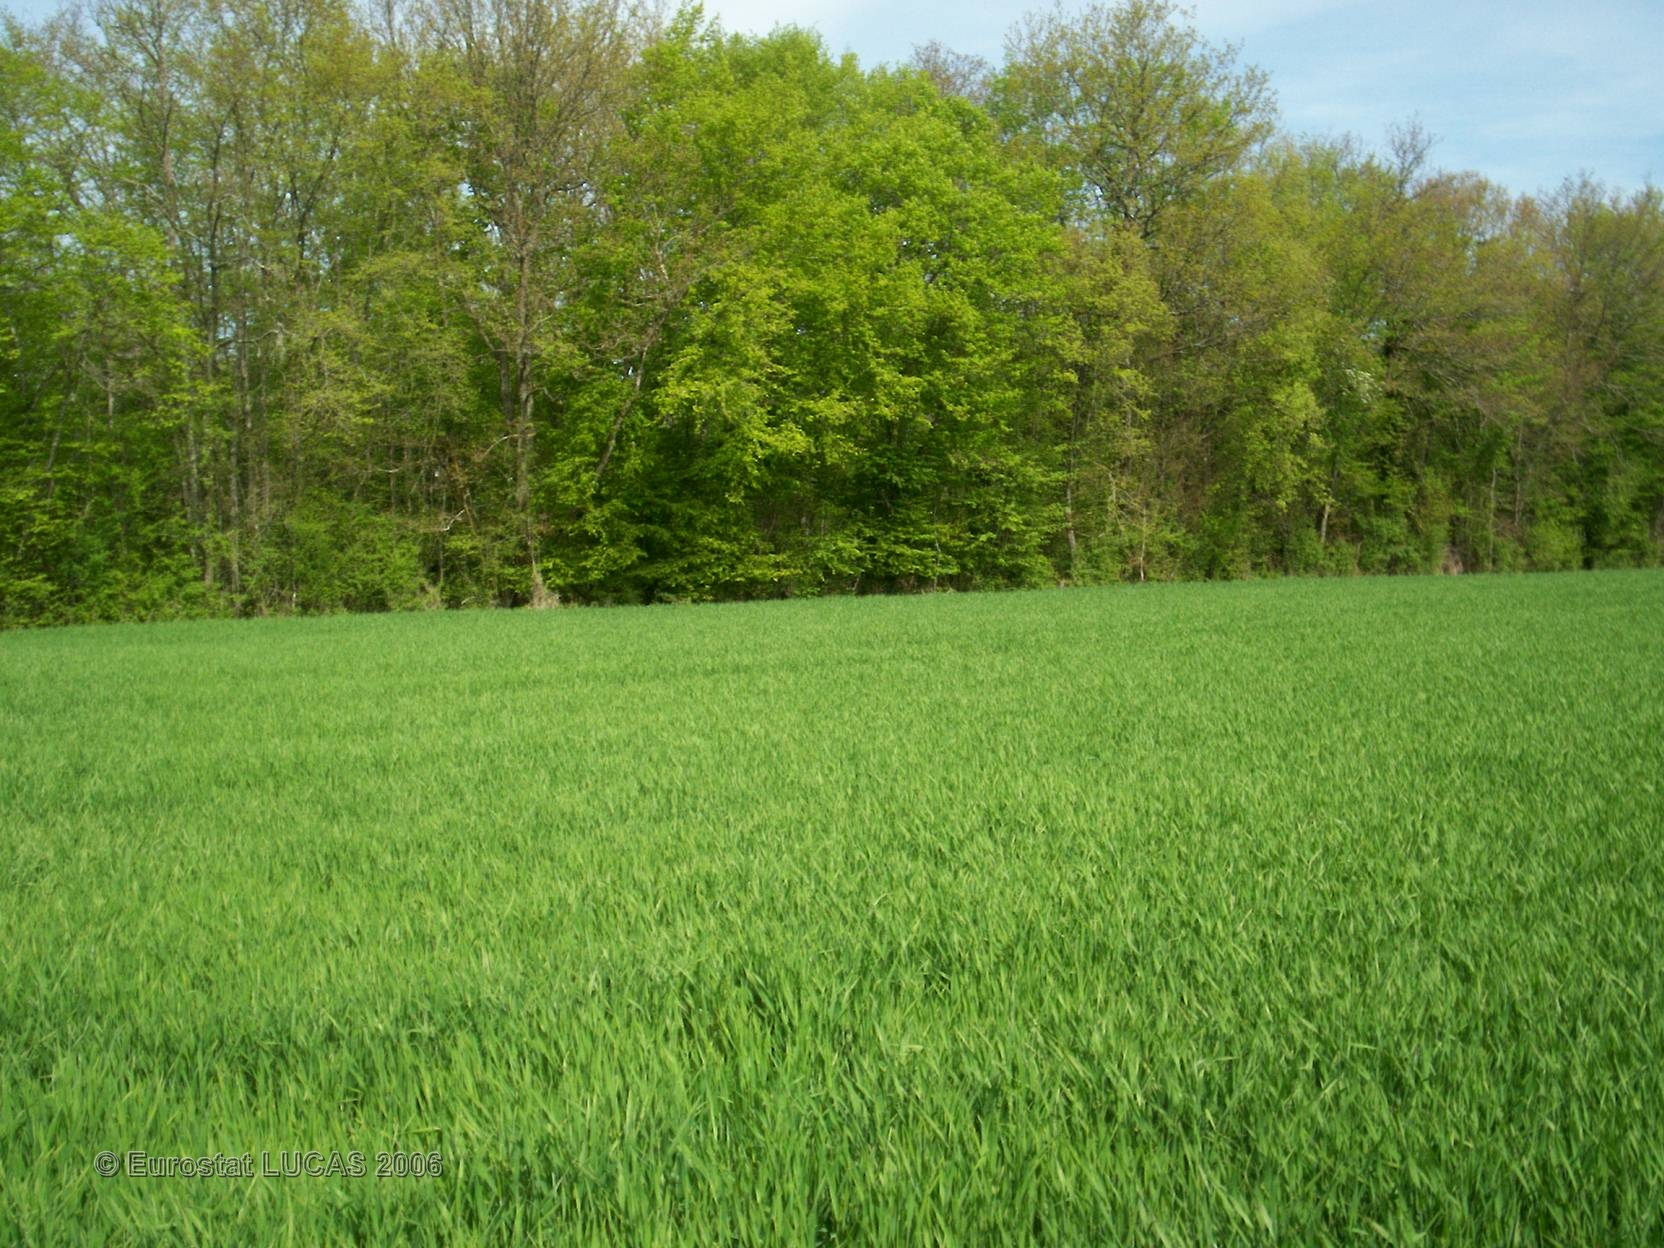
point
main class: Cropland
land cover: Barley
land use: Agriculture (excluding fallow land and kitchen gardens)
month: May
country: FR
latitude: 47.8521
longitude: 4.5055
